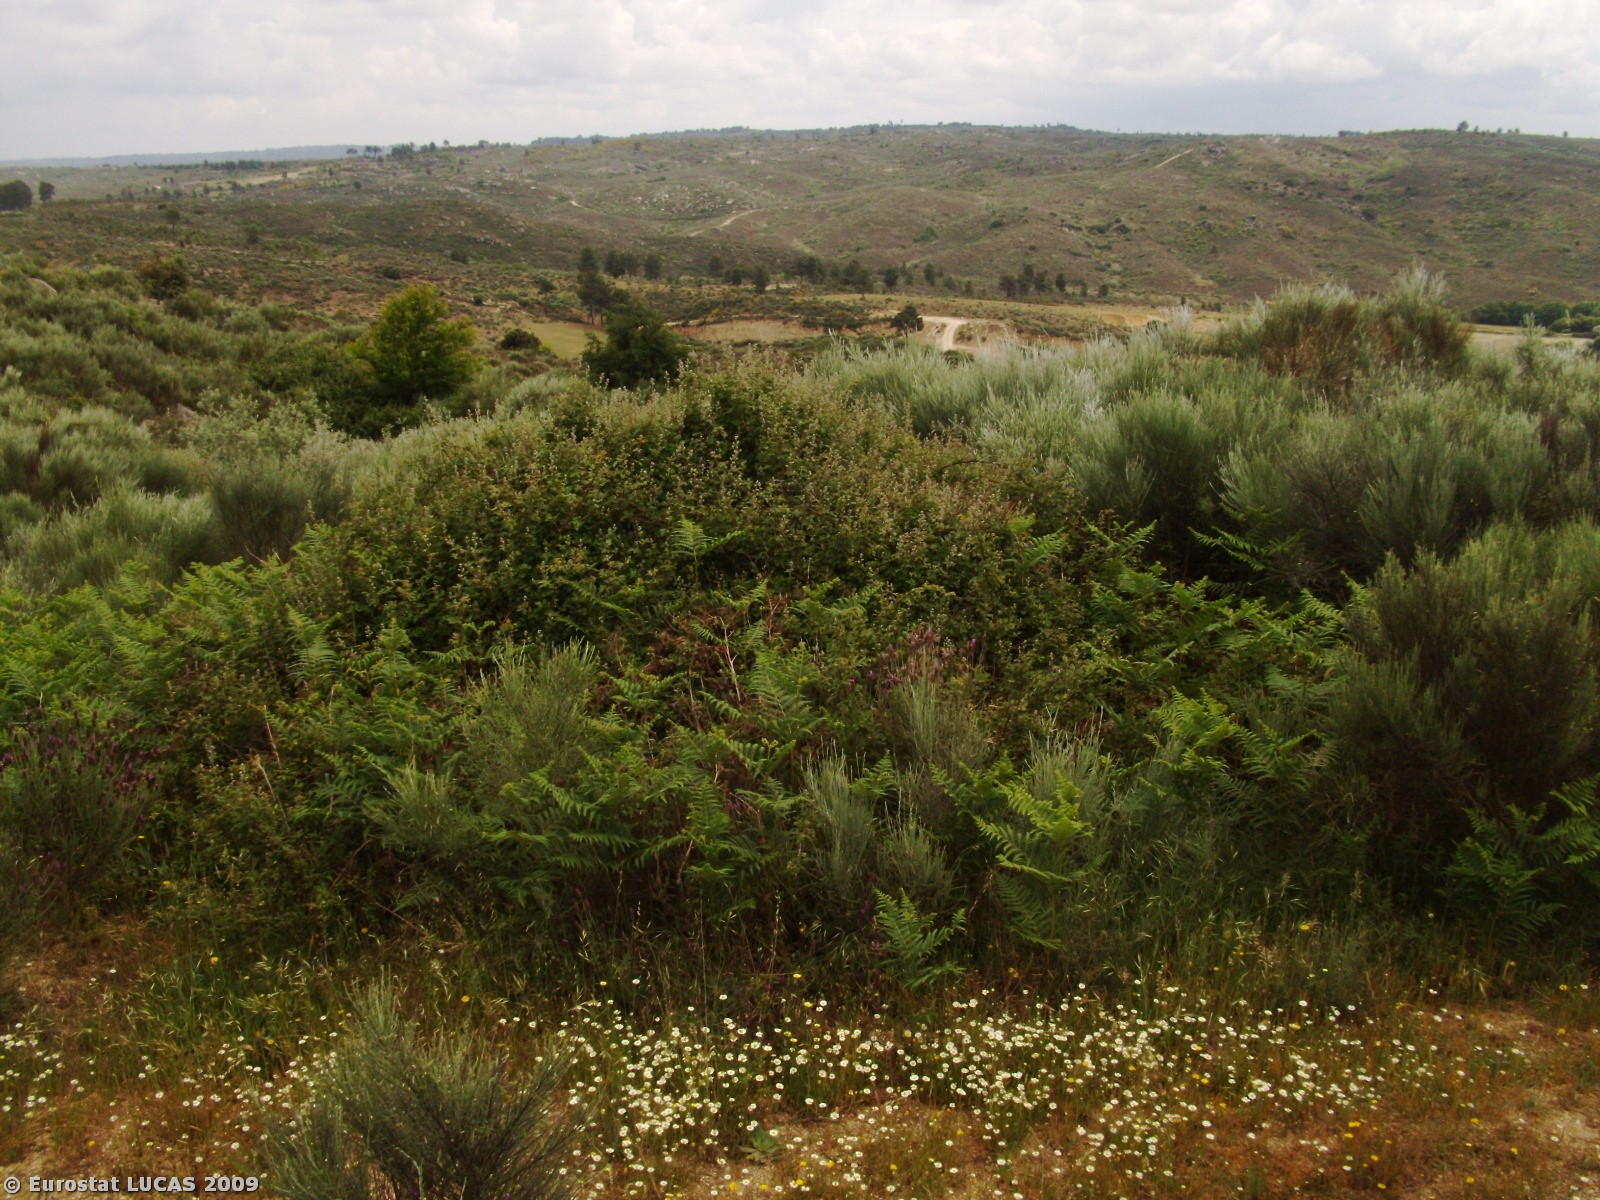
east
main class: Grassland
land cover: Spontaneously vegetated surfaces
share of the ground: > 75 %
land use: Fallow land
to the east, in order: Spontaneously vegetated surfaces; Shrubland without tree cover; Bare land; Tracks; Bare land; Shrubland without tree cover; Bare land; Tracks; Bare land
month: May
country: PT
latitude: 40.6947
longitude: -7.2799
